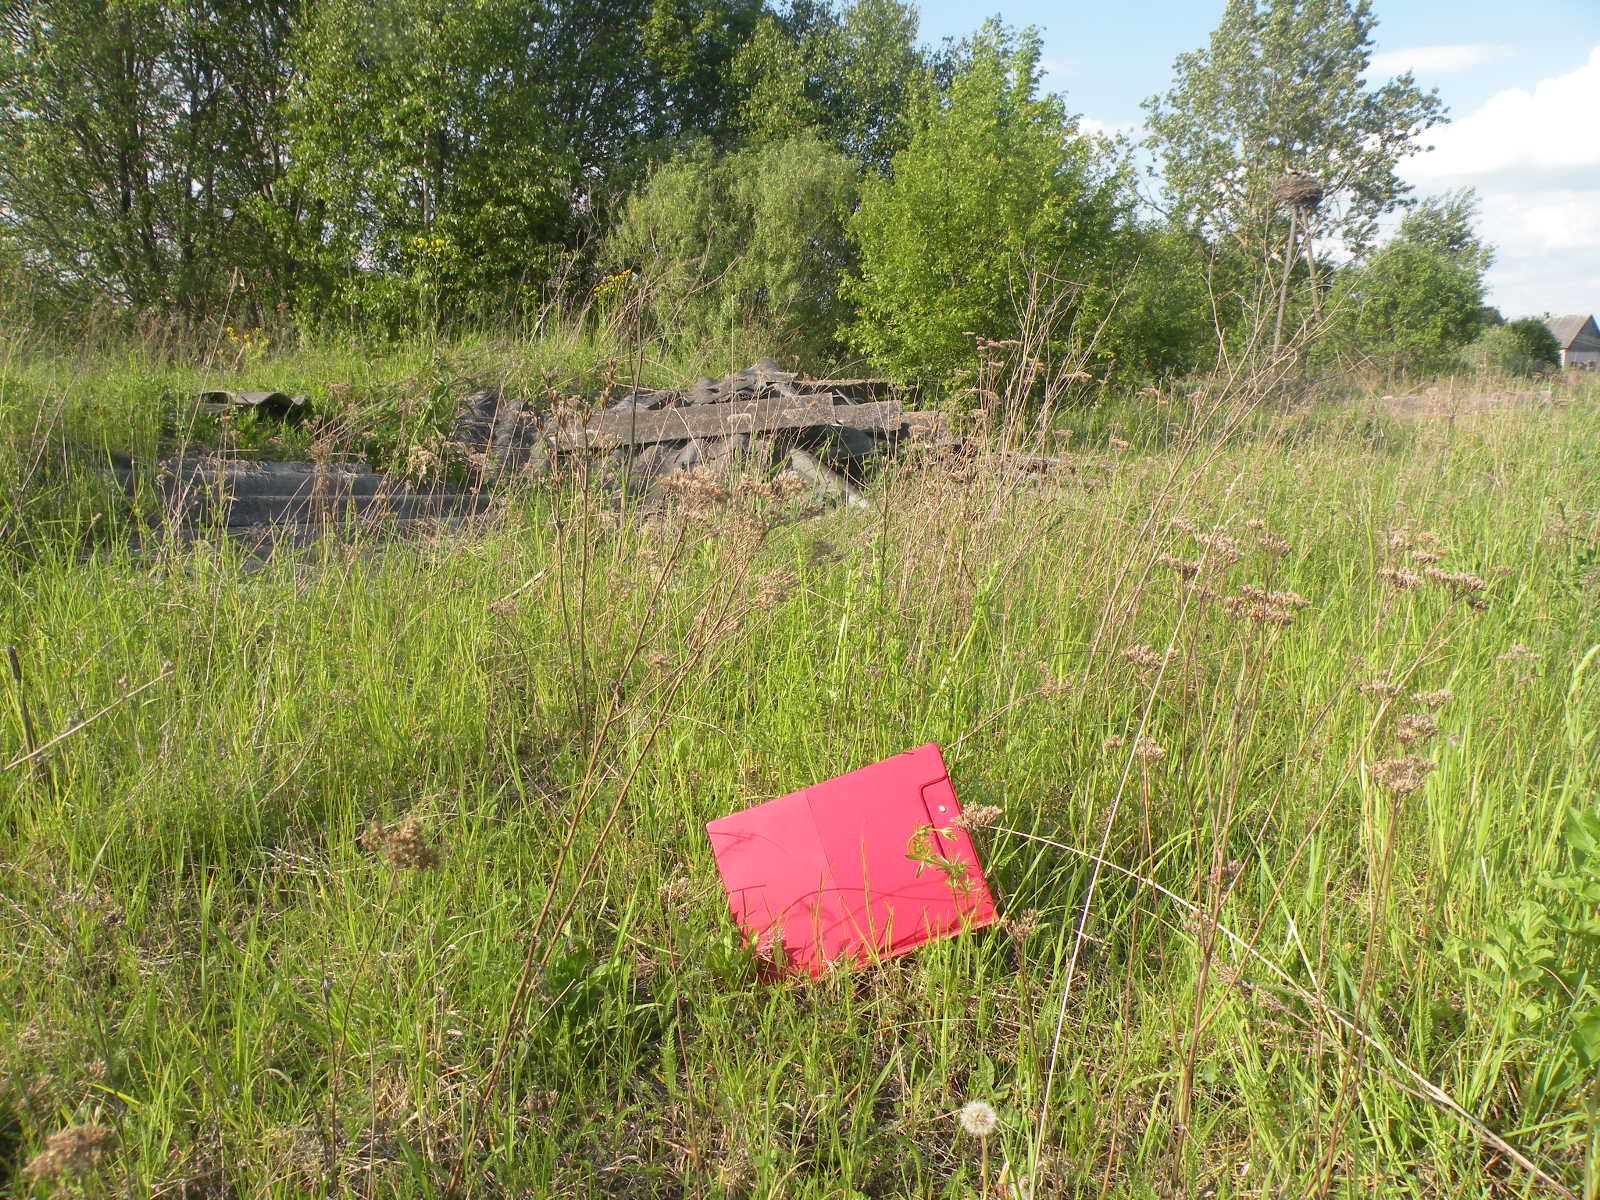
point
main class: Grassland
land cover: Spontaneously vegetated surfaces
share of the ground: > 75 %
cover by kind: herbaceous plants 95 %, shrubs 5 %
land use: Abandoned areas
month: May
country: LV
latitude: 55.9252
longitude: 26.1605
